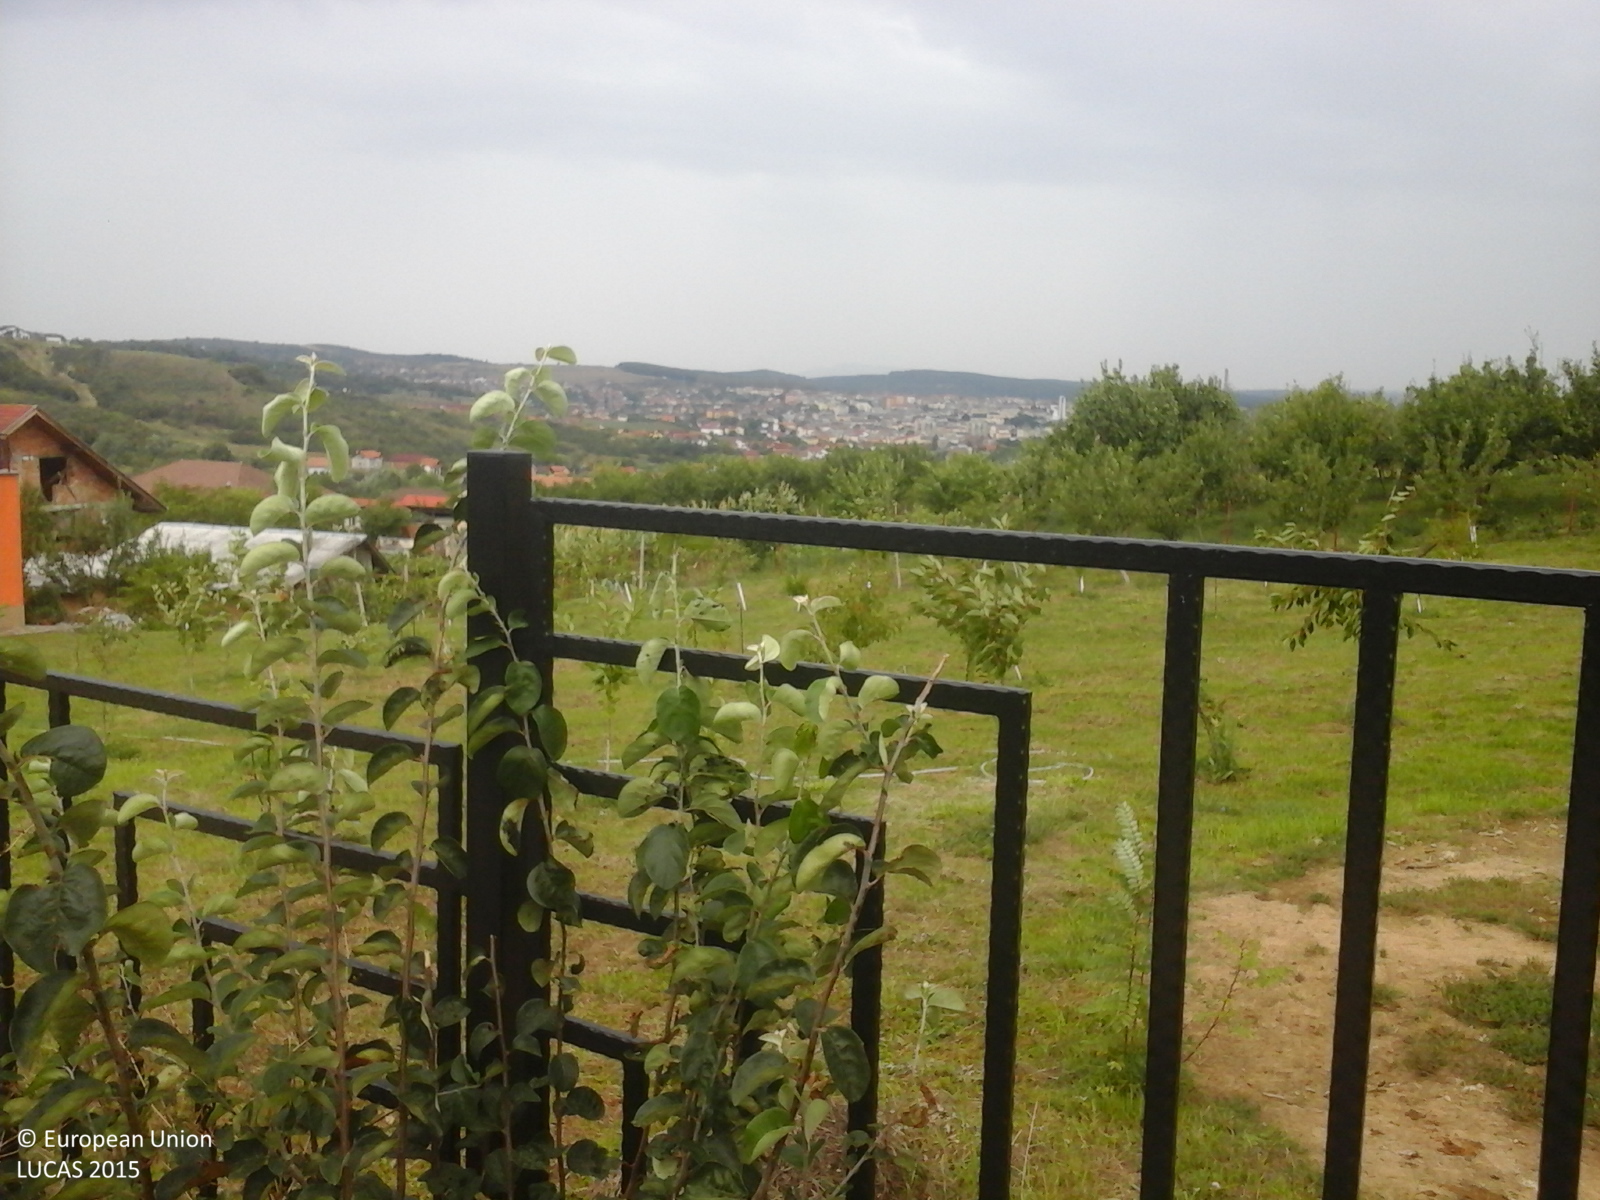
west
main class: Cropland
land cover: Other fruit trees and berries
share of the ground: 25 - 50 %
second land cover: Grassland without tree/shrub cover
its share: > 75 %
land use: Agriculture (excluding fallow land and kitchen gardens)
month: September
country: RO
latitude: 47.1838
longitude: 23.0896
